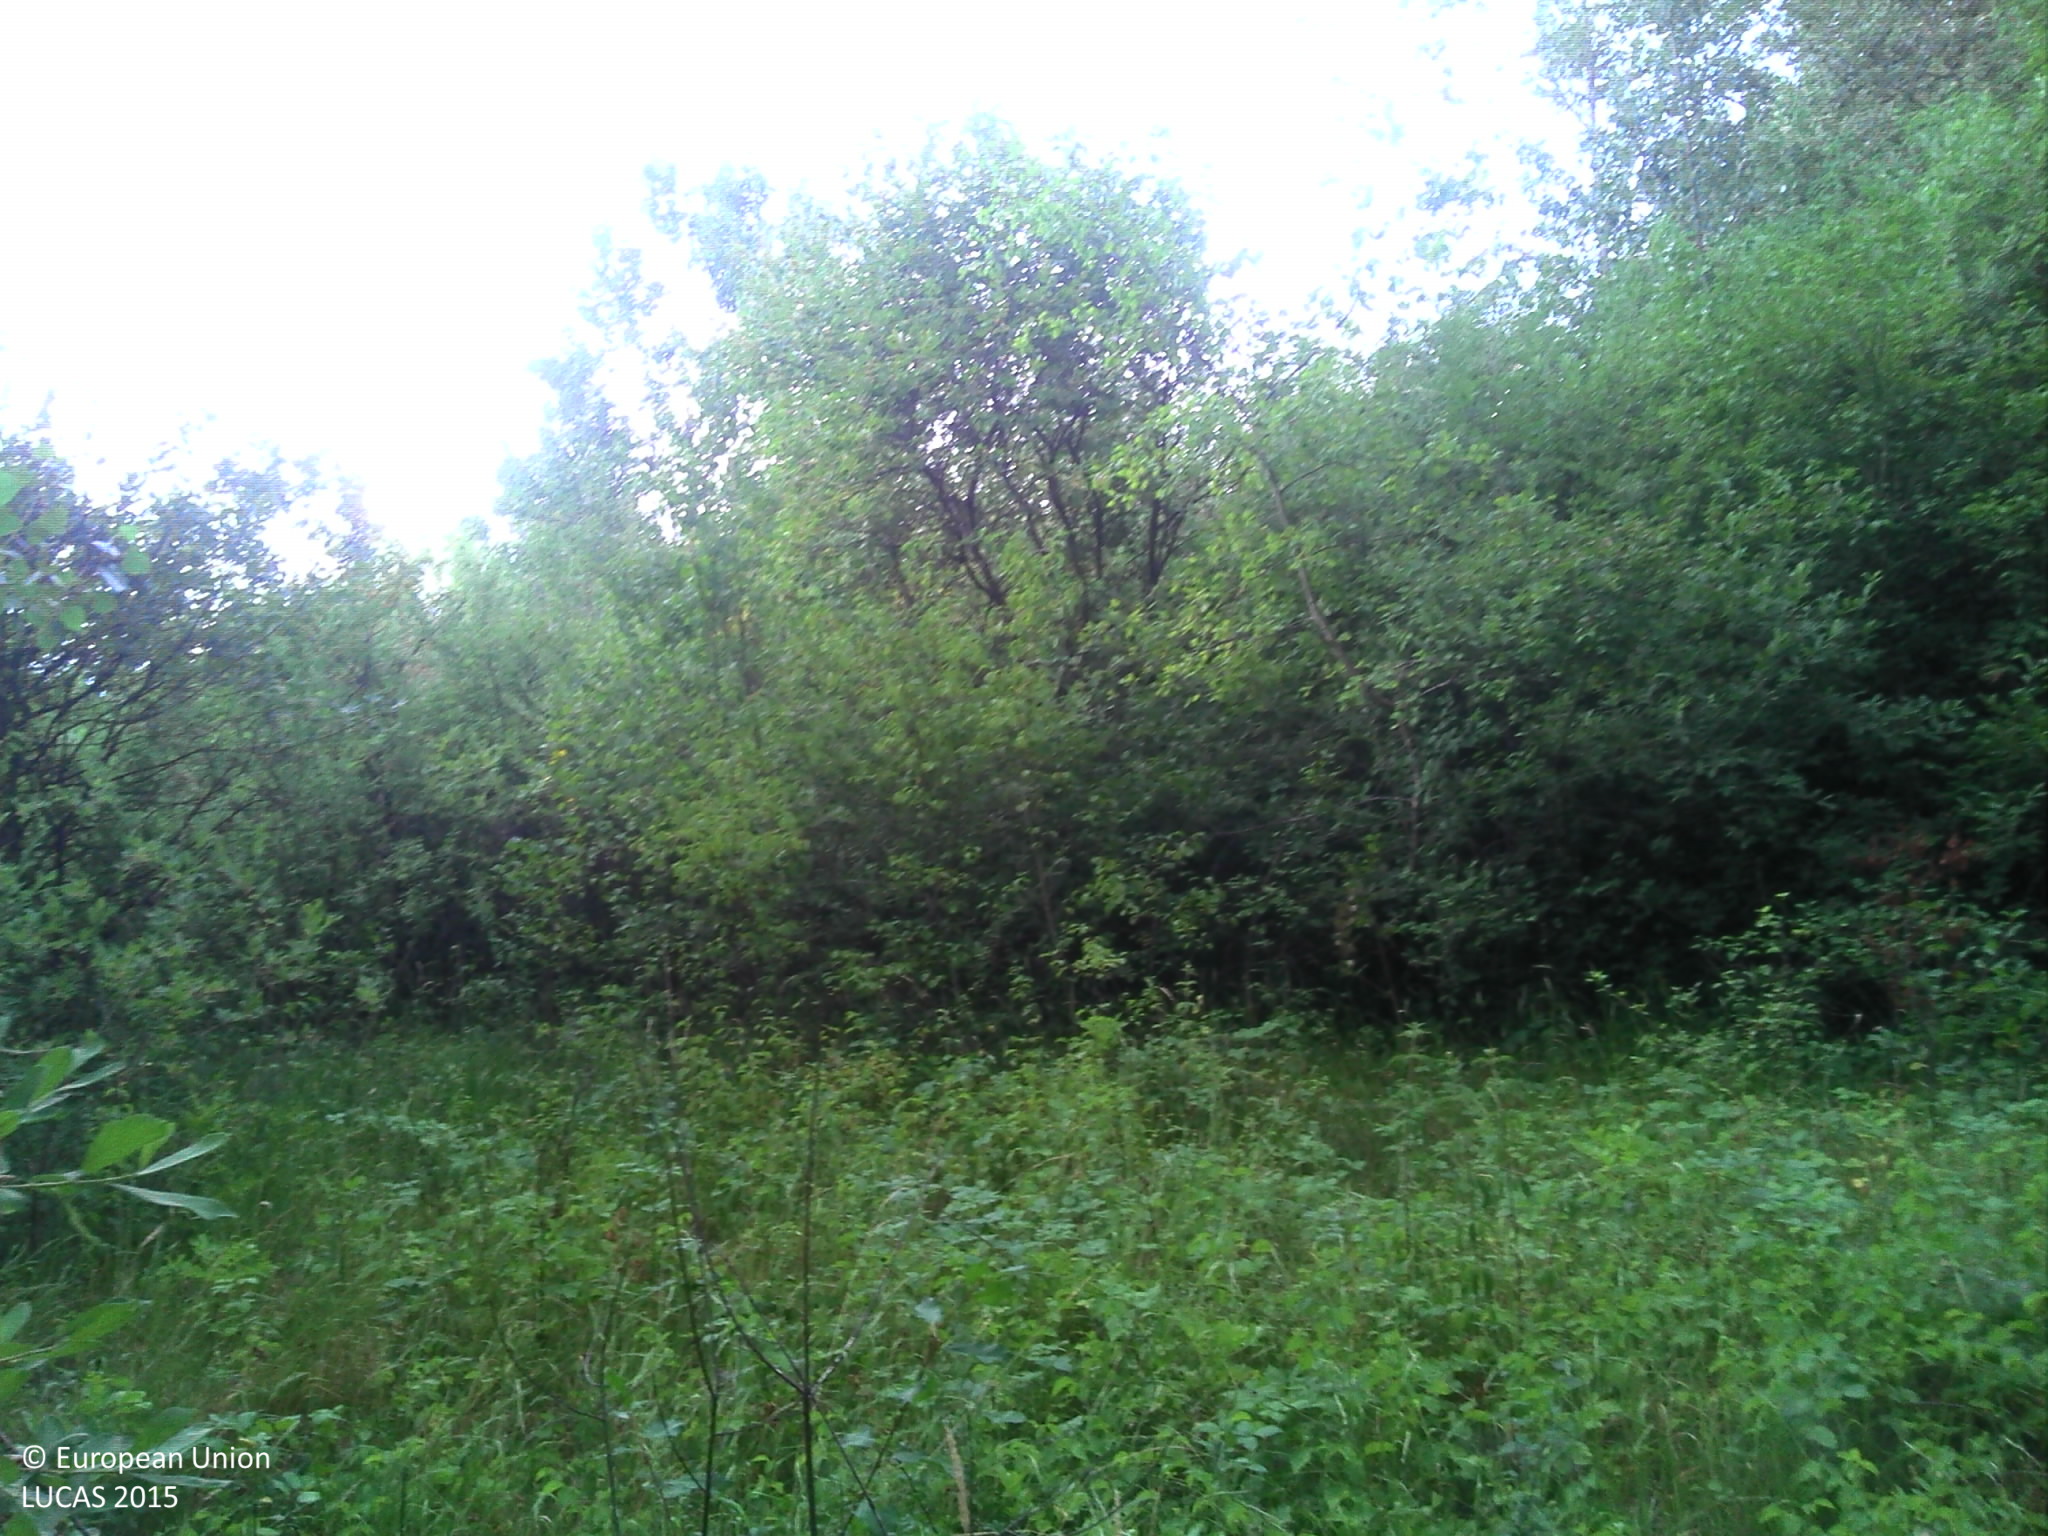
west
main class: Woodland
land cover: Broadleaved woodland
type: beech forest
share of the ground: > 75 %
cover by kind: broadleaved forest trees 60 %, herbaceous plants 30 %, lichens and mosses 10 %
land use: Semi-natural and natural areas not in use
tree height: > 5 m
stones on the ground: < 10 %
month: July
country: FR
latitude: 46.1435
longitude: 6.3140
